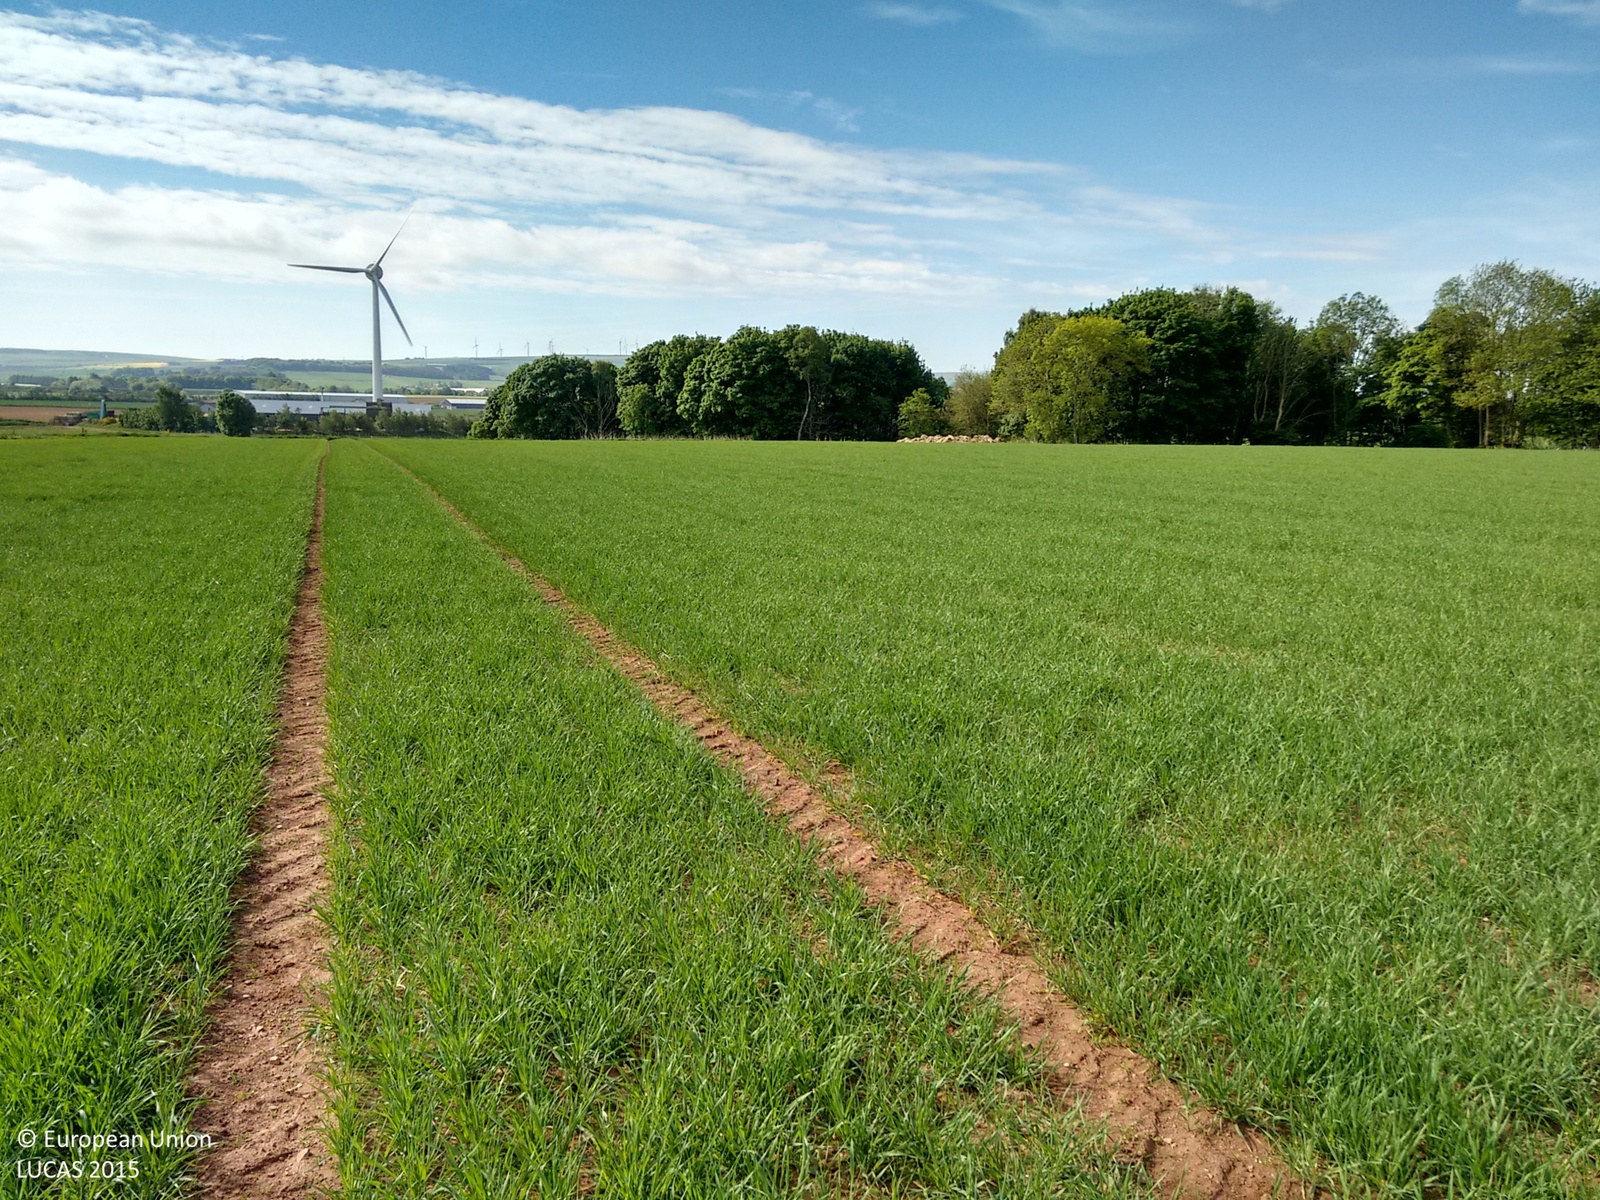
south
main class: Cropland
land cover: Barley
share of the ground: 25 - 50 %
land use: Agriculture (excluding fallow land and kitchen gardens)
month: June
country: GB
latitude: 56.8937
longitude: -2.4154
